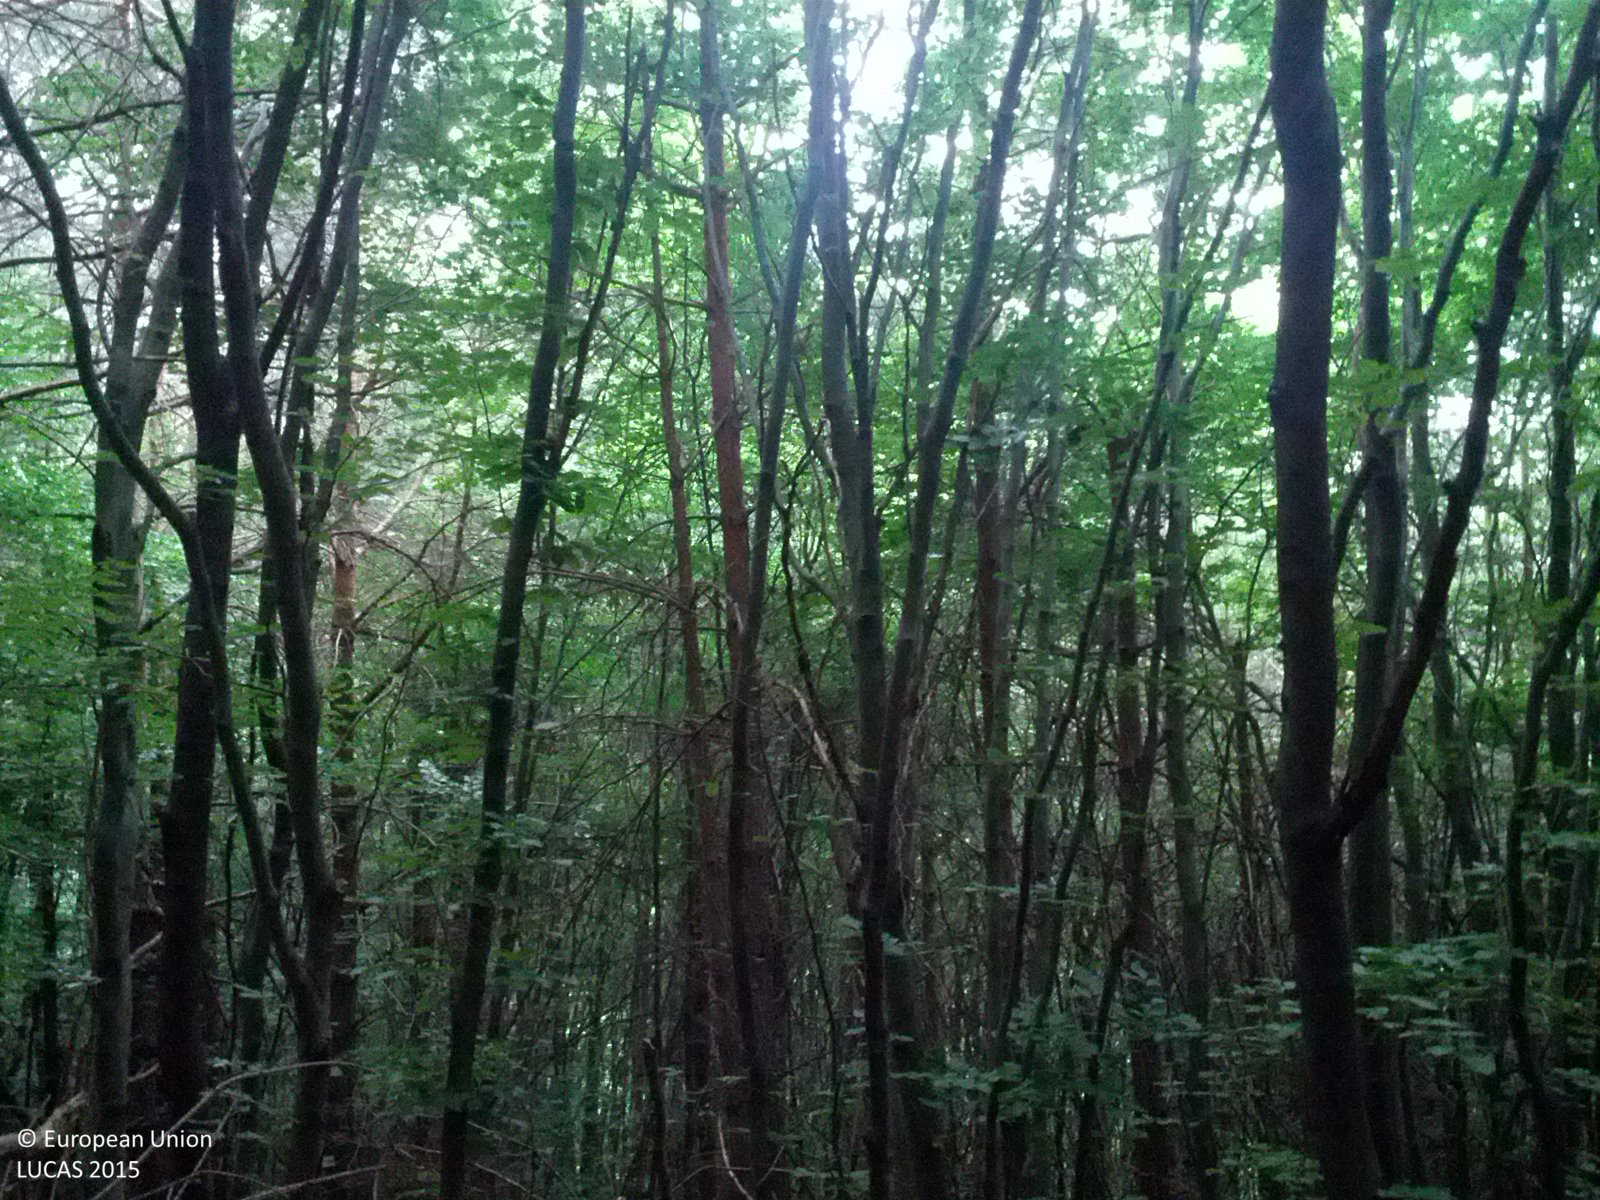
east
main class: Woodland
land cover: Broadleaved woodland
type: beech forest
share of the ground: > 75 %
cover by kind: broadleaved forest trees 100 %
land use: Forestry
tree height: > 5 m
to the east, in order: Broadleaved woodland; Paved roads, cycling and walking lanes; Broadleaved woodland; Rivers and streams; Broadleaved woodland; Tracks; Broadleaved woodland
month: June
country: AT
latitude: 48.2170
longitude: 16.1010
